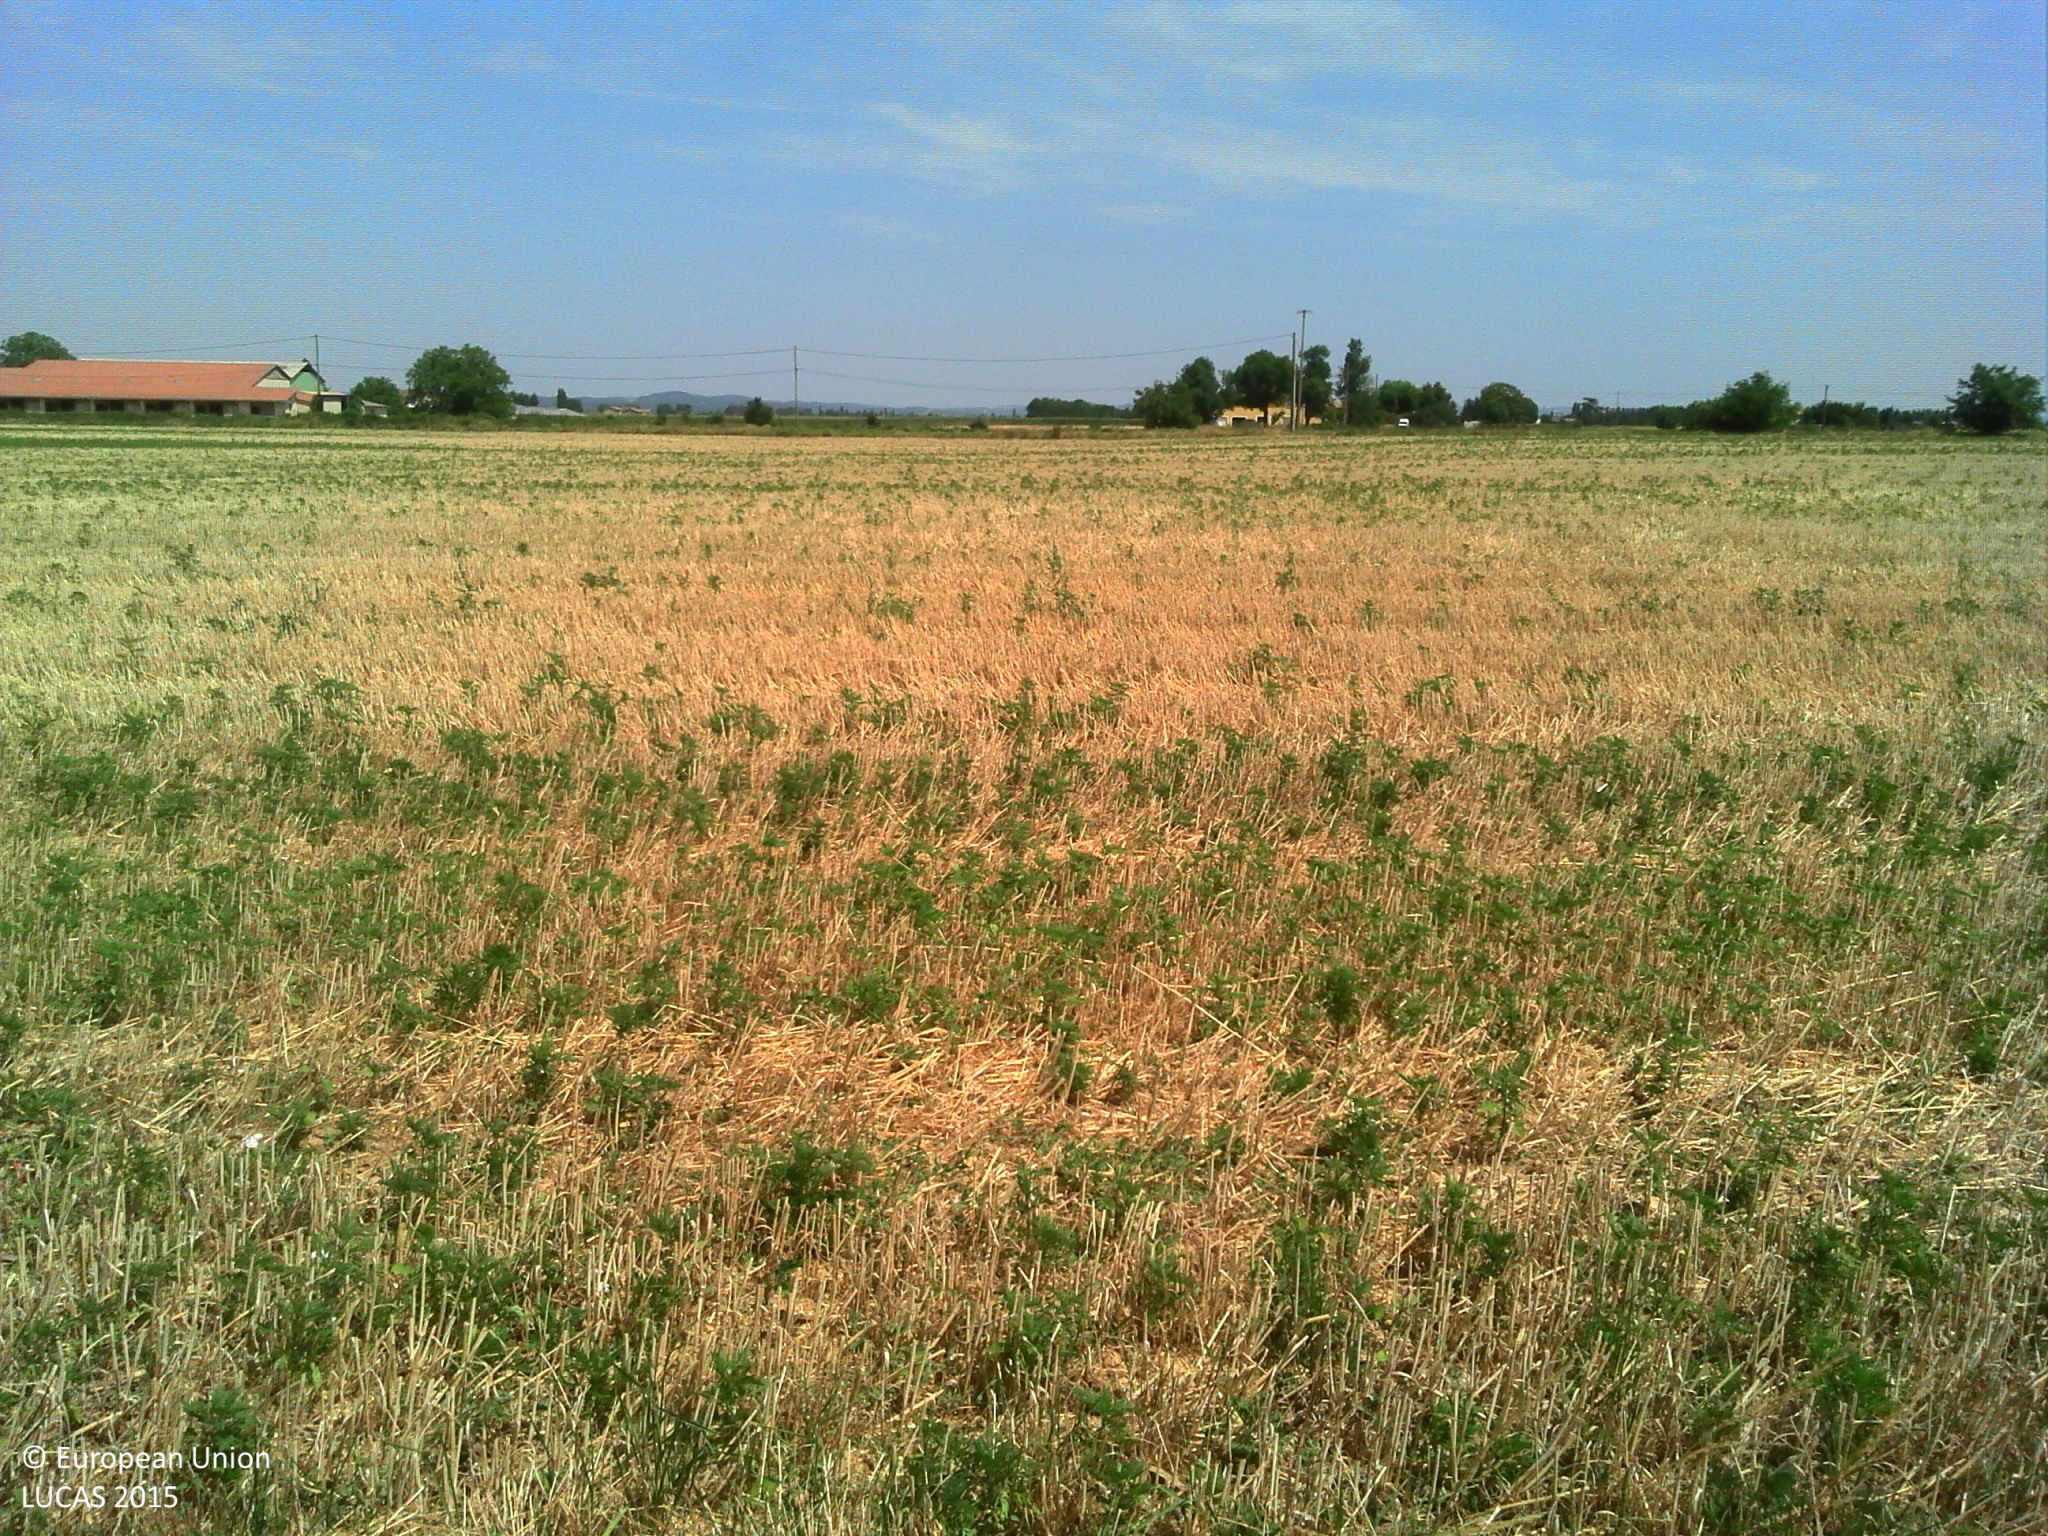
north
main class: Cropland
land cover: Barley
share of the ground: > 75 %
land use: Agriculture (excluding fallow land and kitchen gardens)
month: July
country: FR
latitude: 44.9897
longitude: 5.0210
